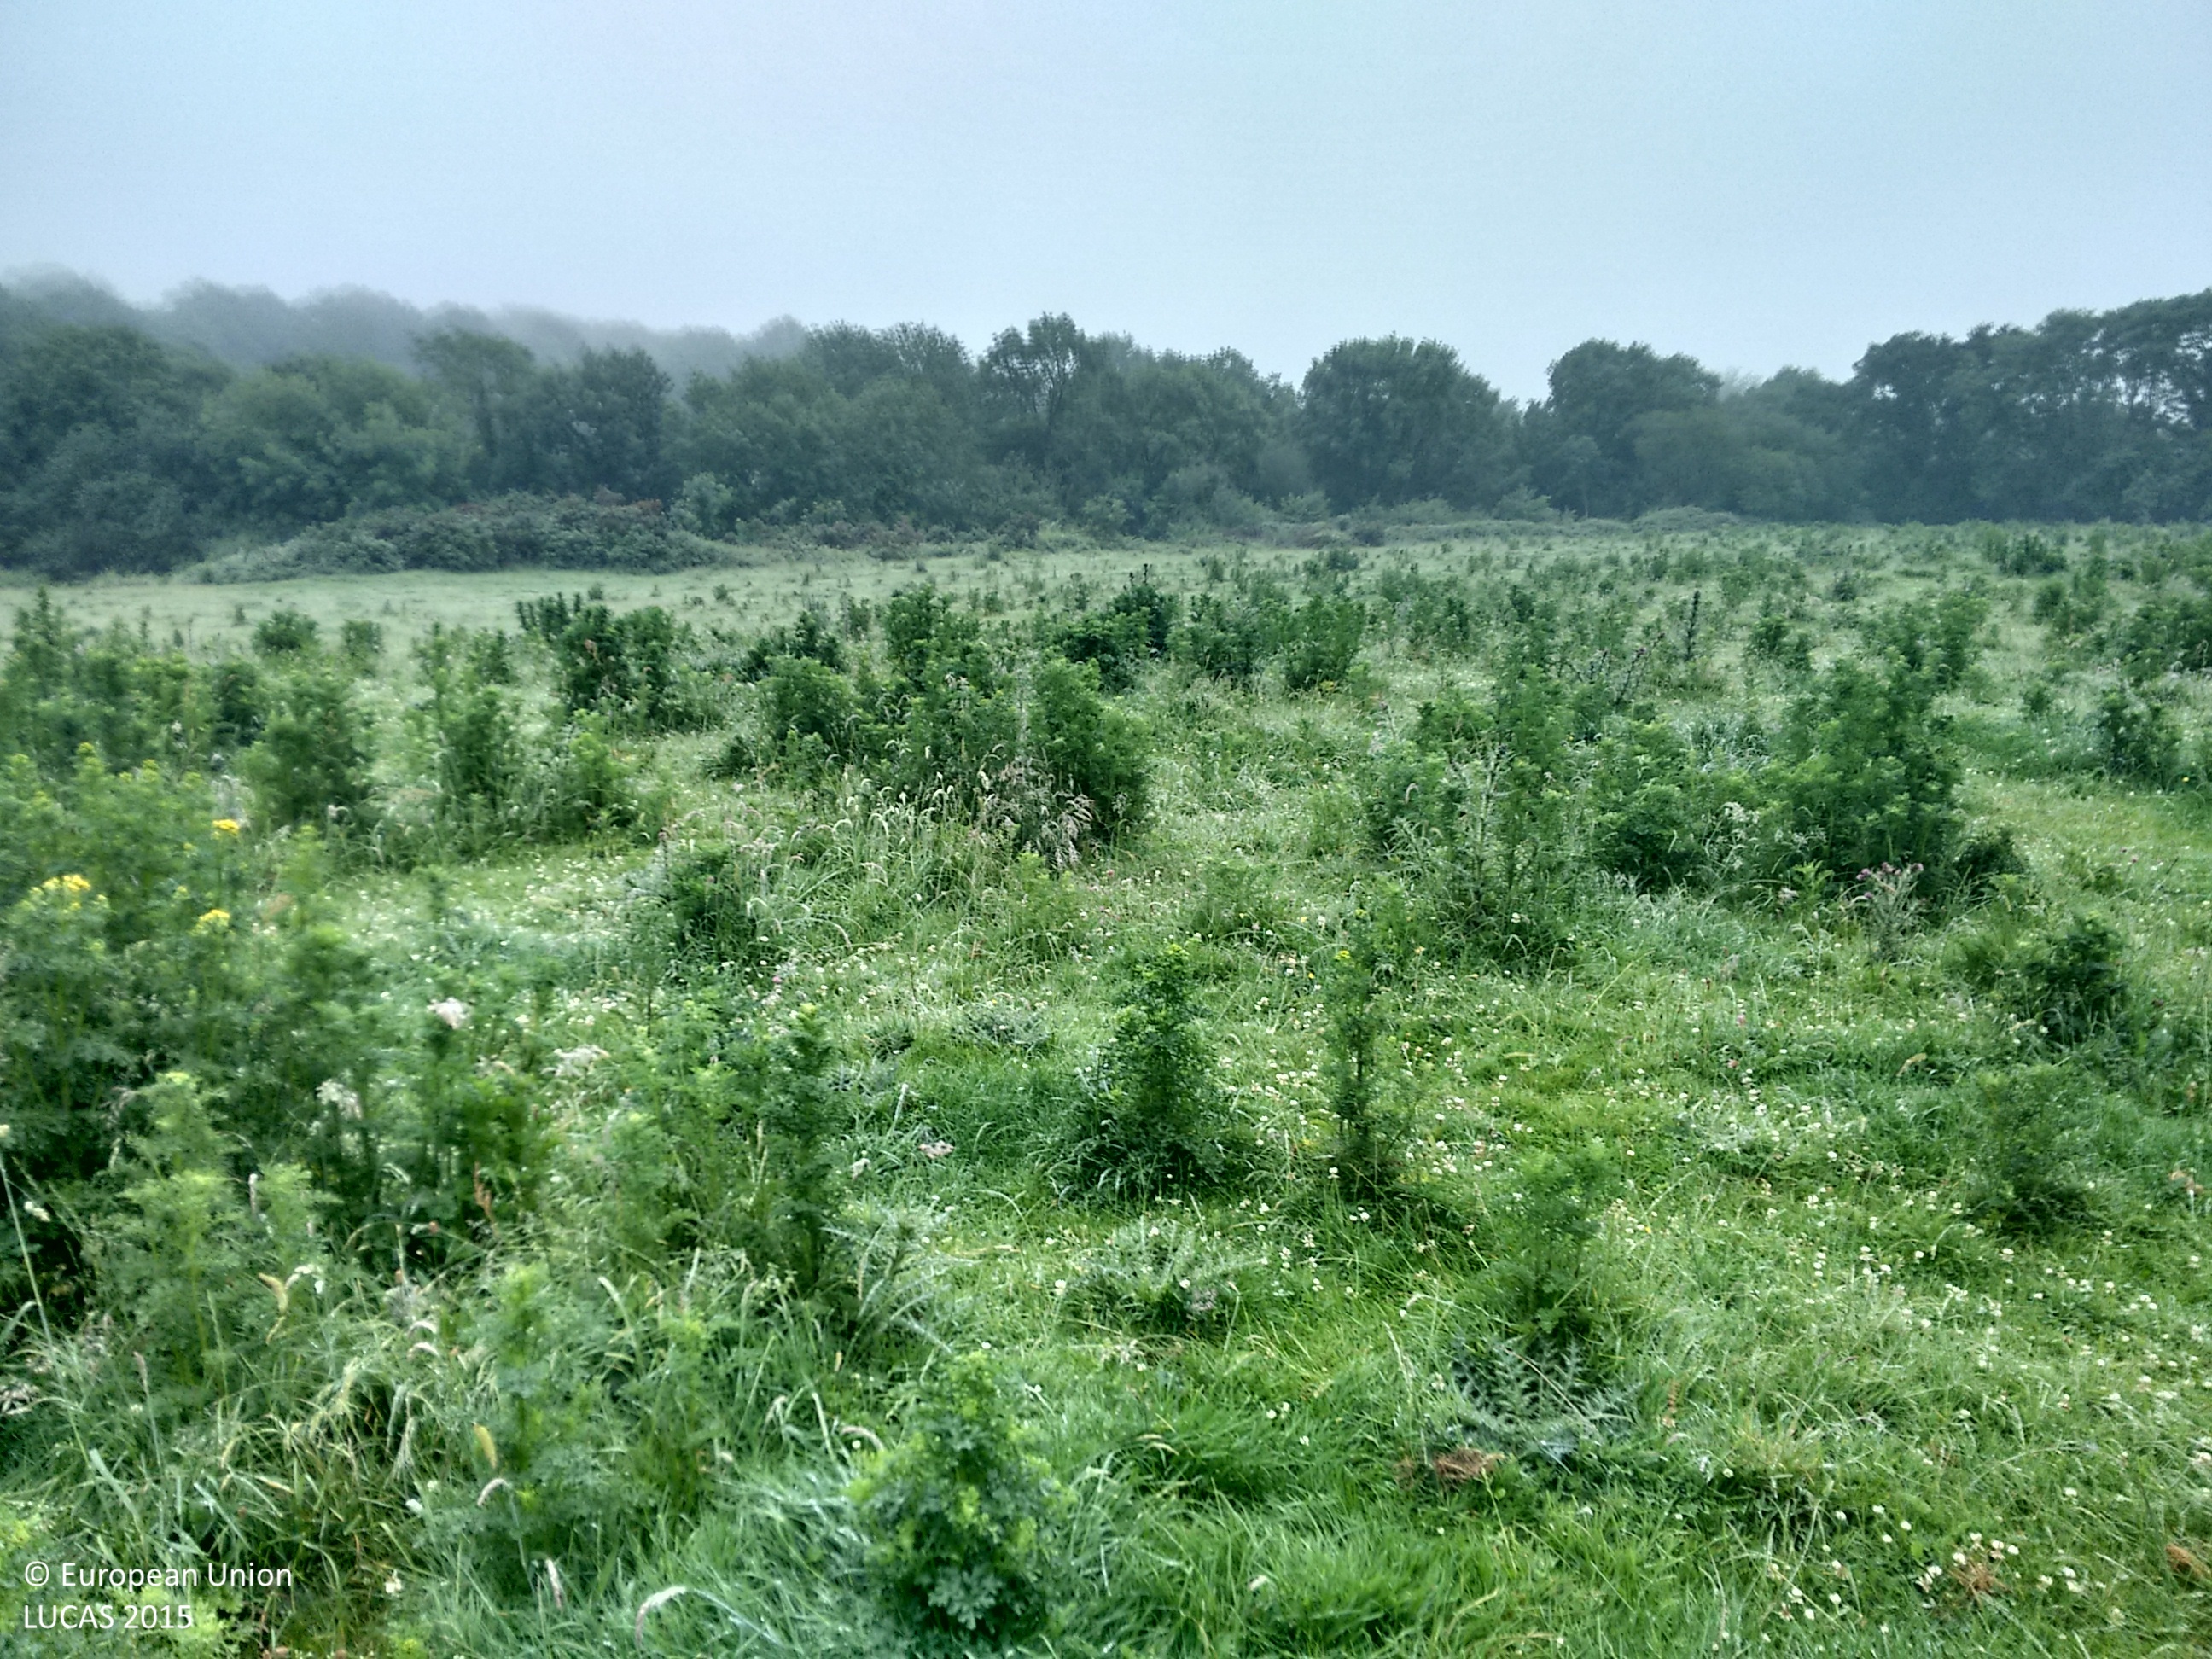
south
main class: Grassland
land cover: Grassland without tree/shrub cover
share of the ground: > 75 %
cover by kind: herbaceous plants 100 %
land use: Agriculture (excluding fallow land and kitchen gardens)
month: June
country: IE
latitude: 52.3823
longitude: -7.2974
